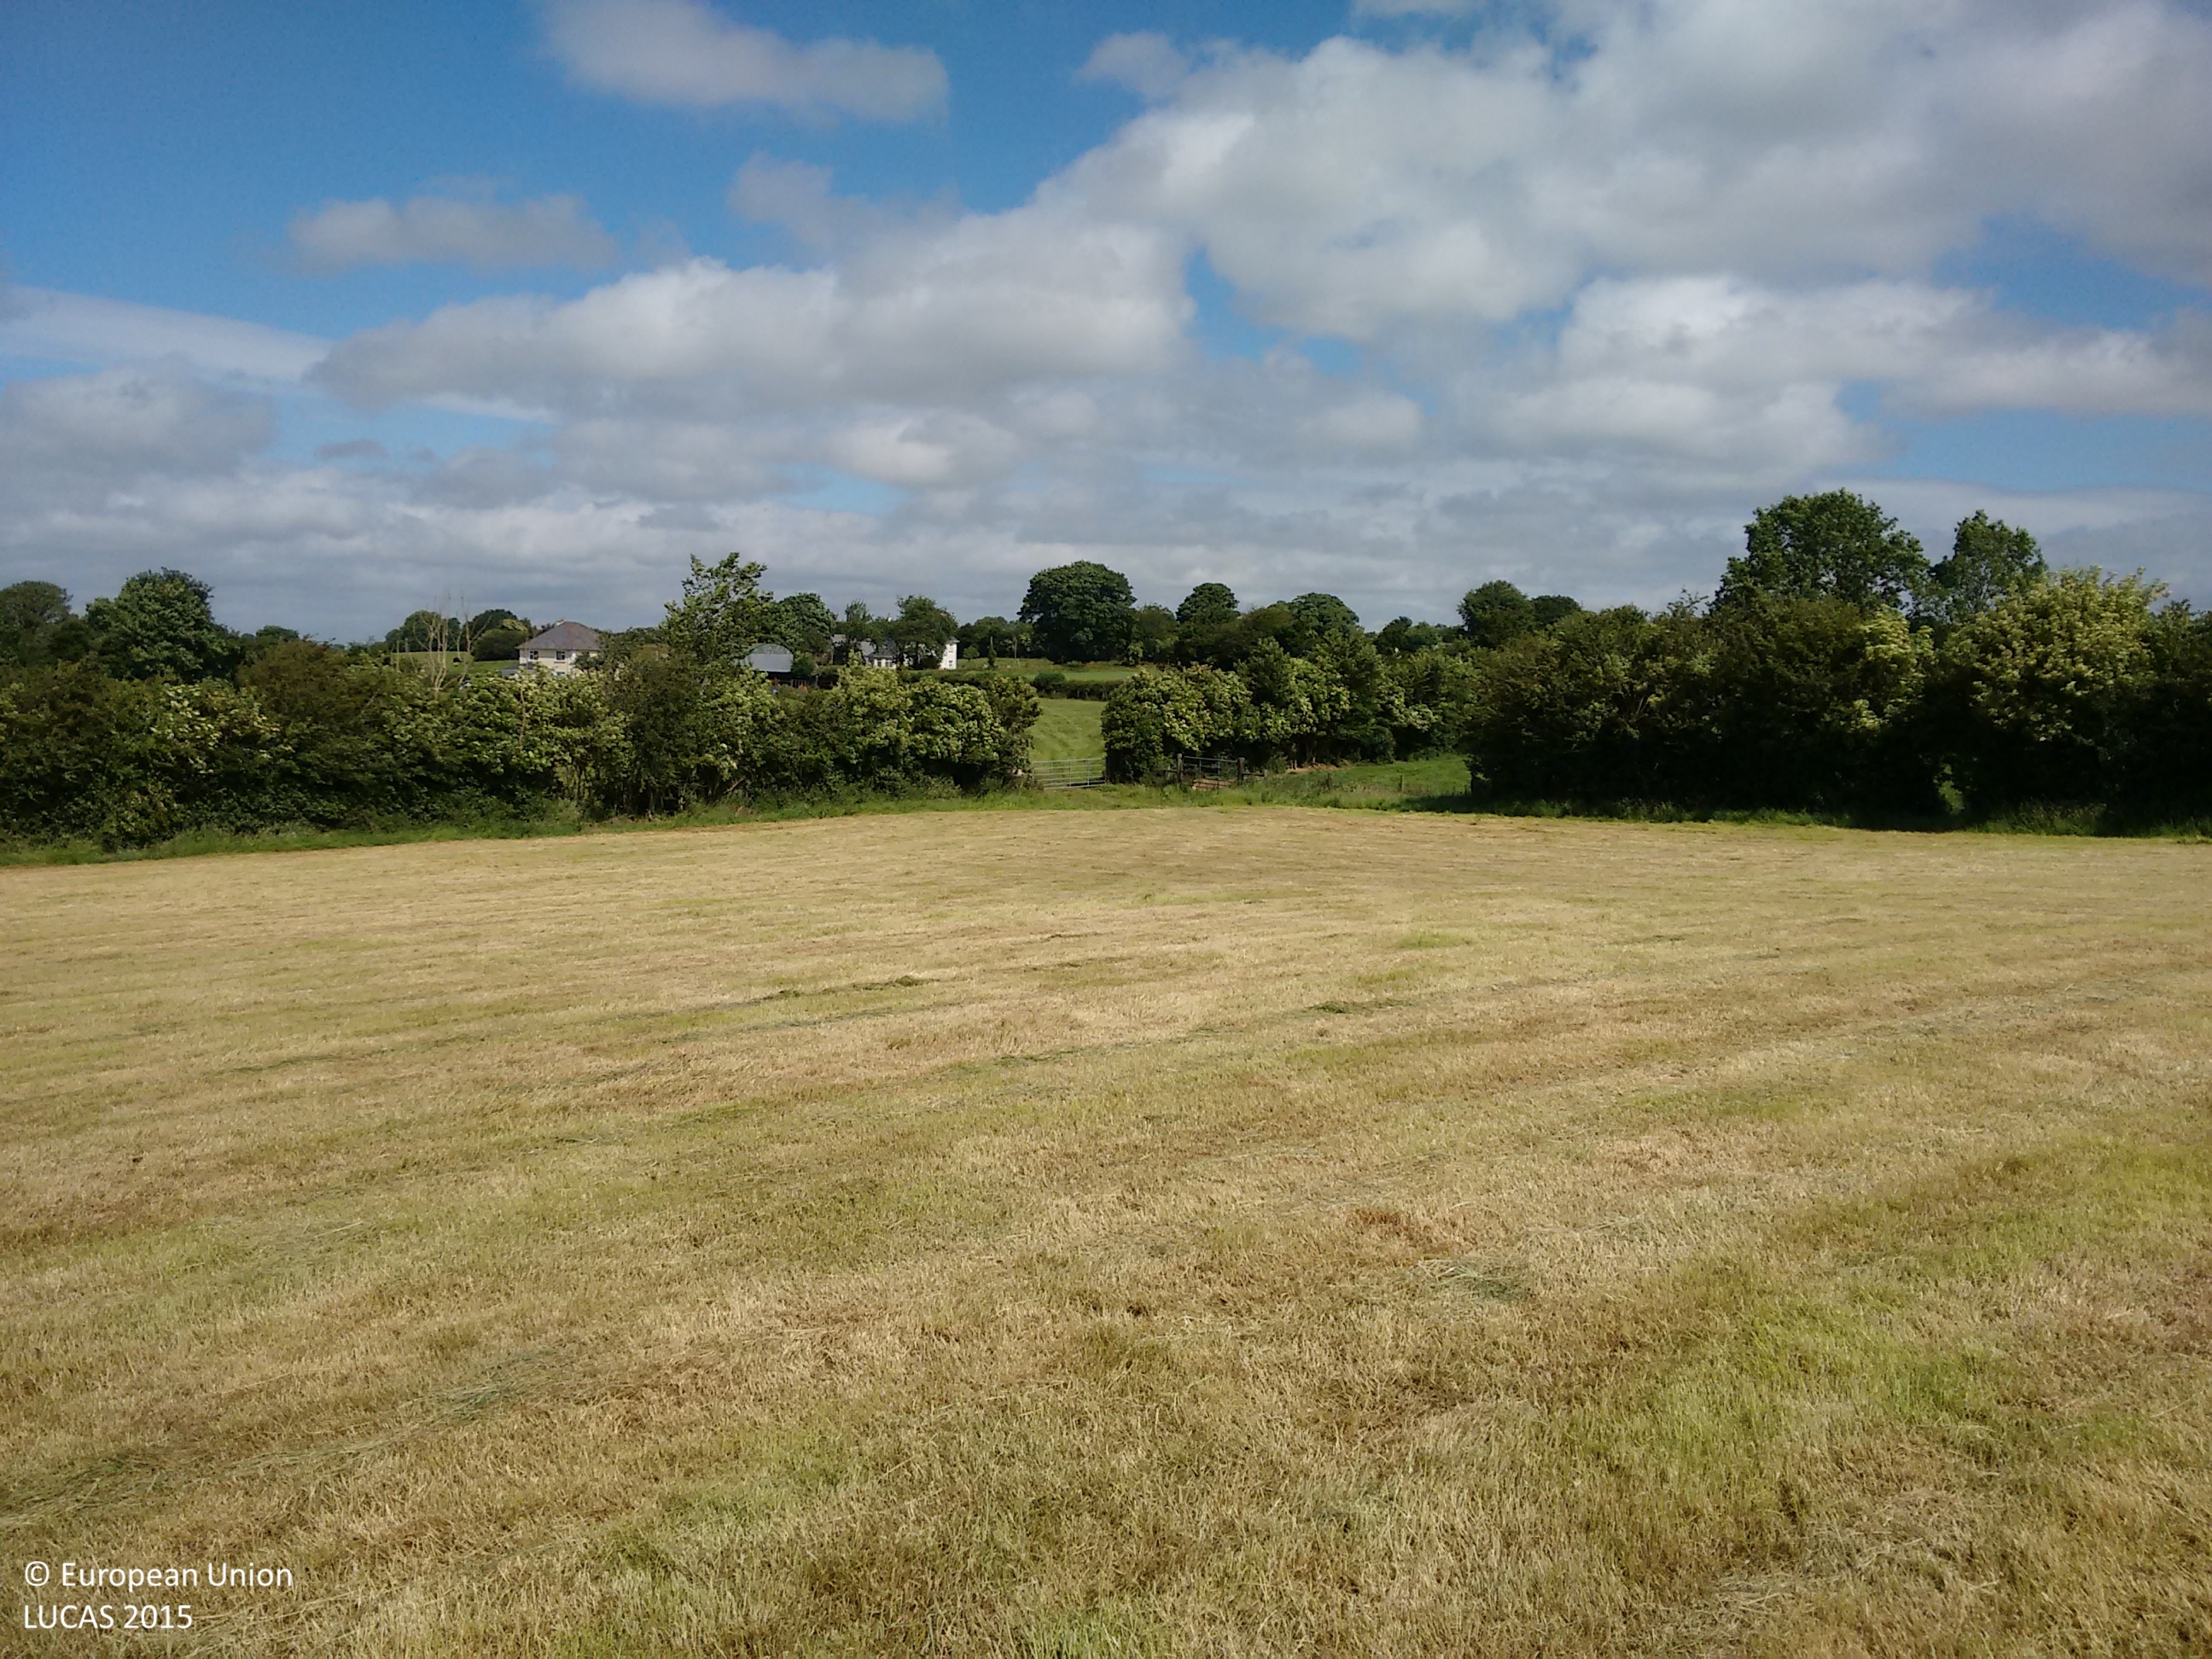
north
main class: Grassland
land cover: Grassland without tree/shrub cover
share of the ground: > 75 %
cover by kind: herbaceous plants 100 %
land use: Agriculture (excluding fallow land and kitchen gardens)
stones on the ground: < 10 %
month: June
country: IE
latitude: 53.7079
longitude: -6.7843
